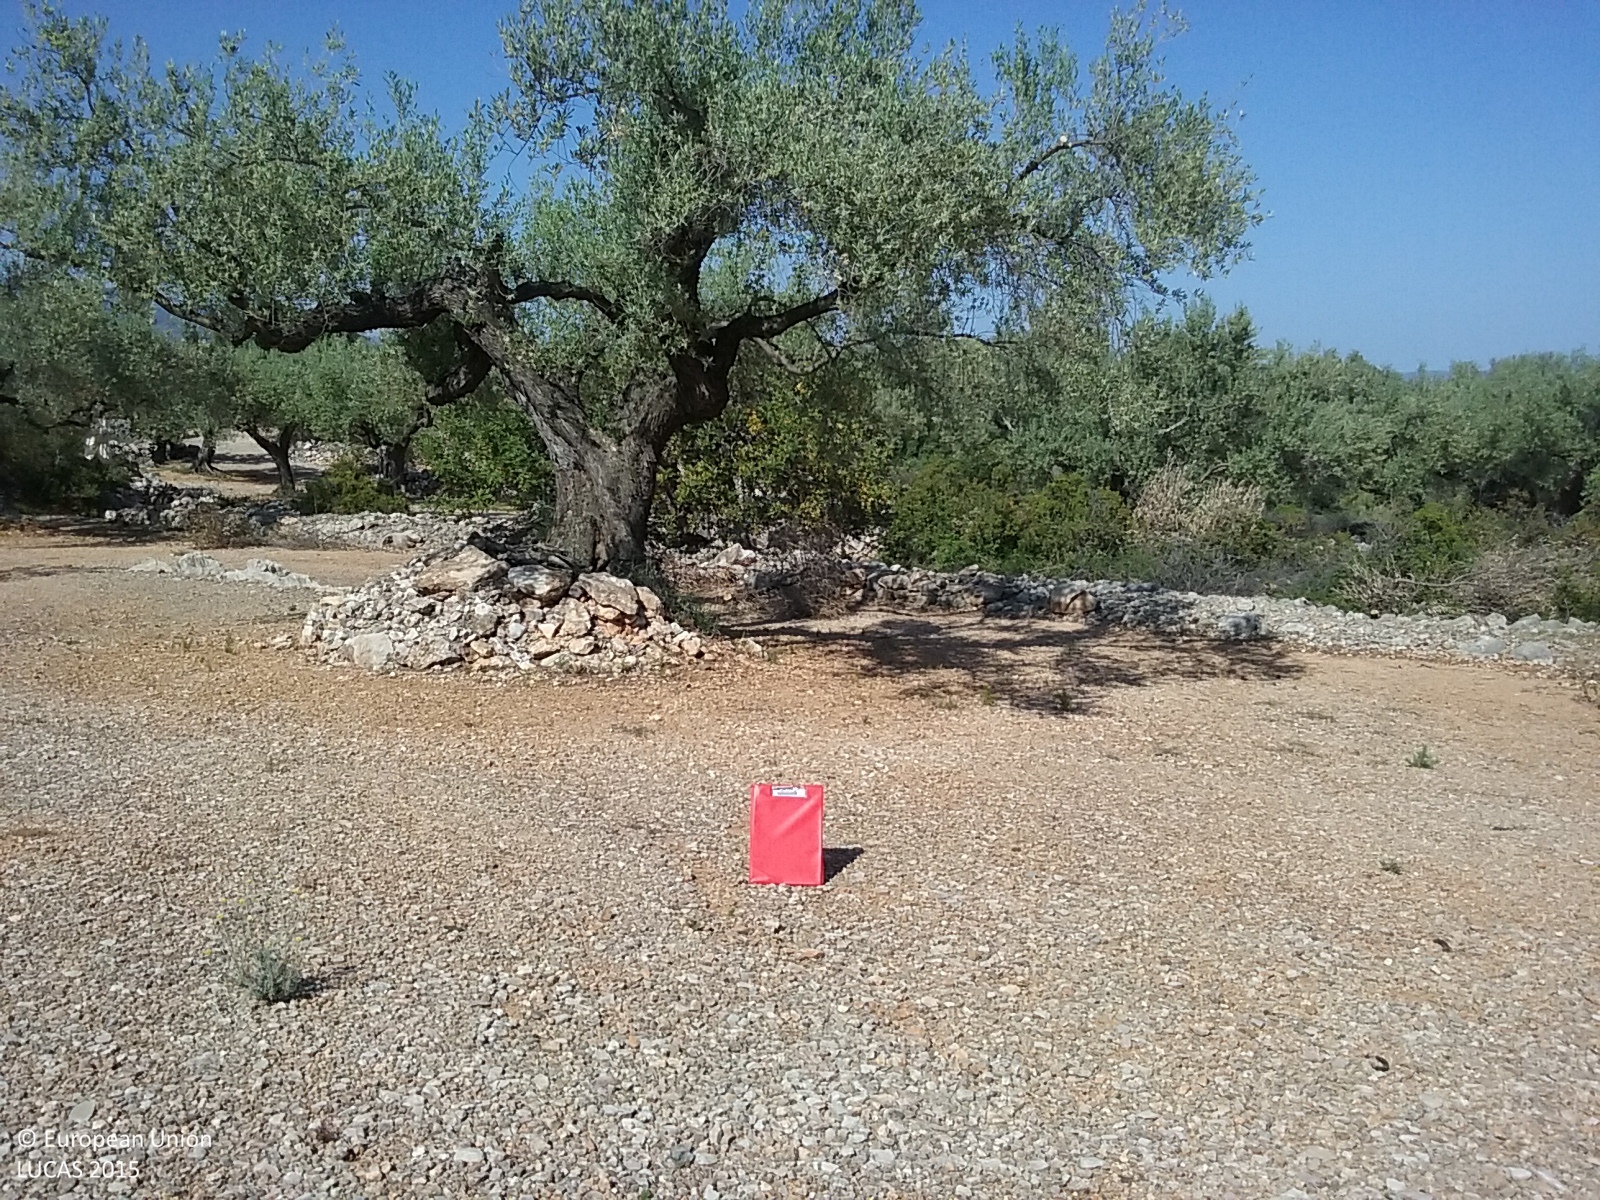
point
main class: Cropland
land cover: Olive groves
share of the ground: 25 - 50 %
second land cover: Other bare soil
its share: > 75 %
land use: Agriculture (excluding fallow land and kitchen gardens)
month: May
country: ES
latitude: 40.5995
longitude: 0.2453
